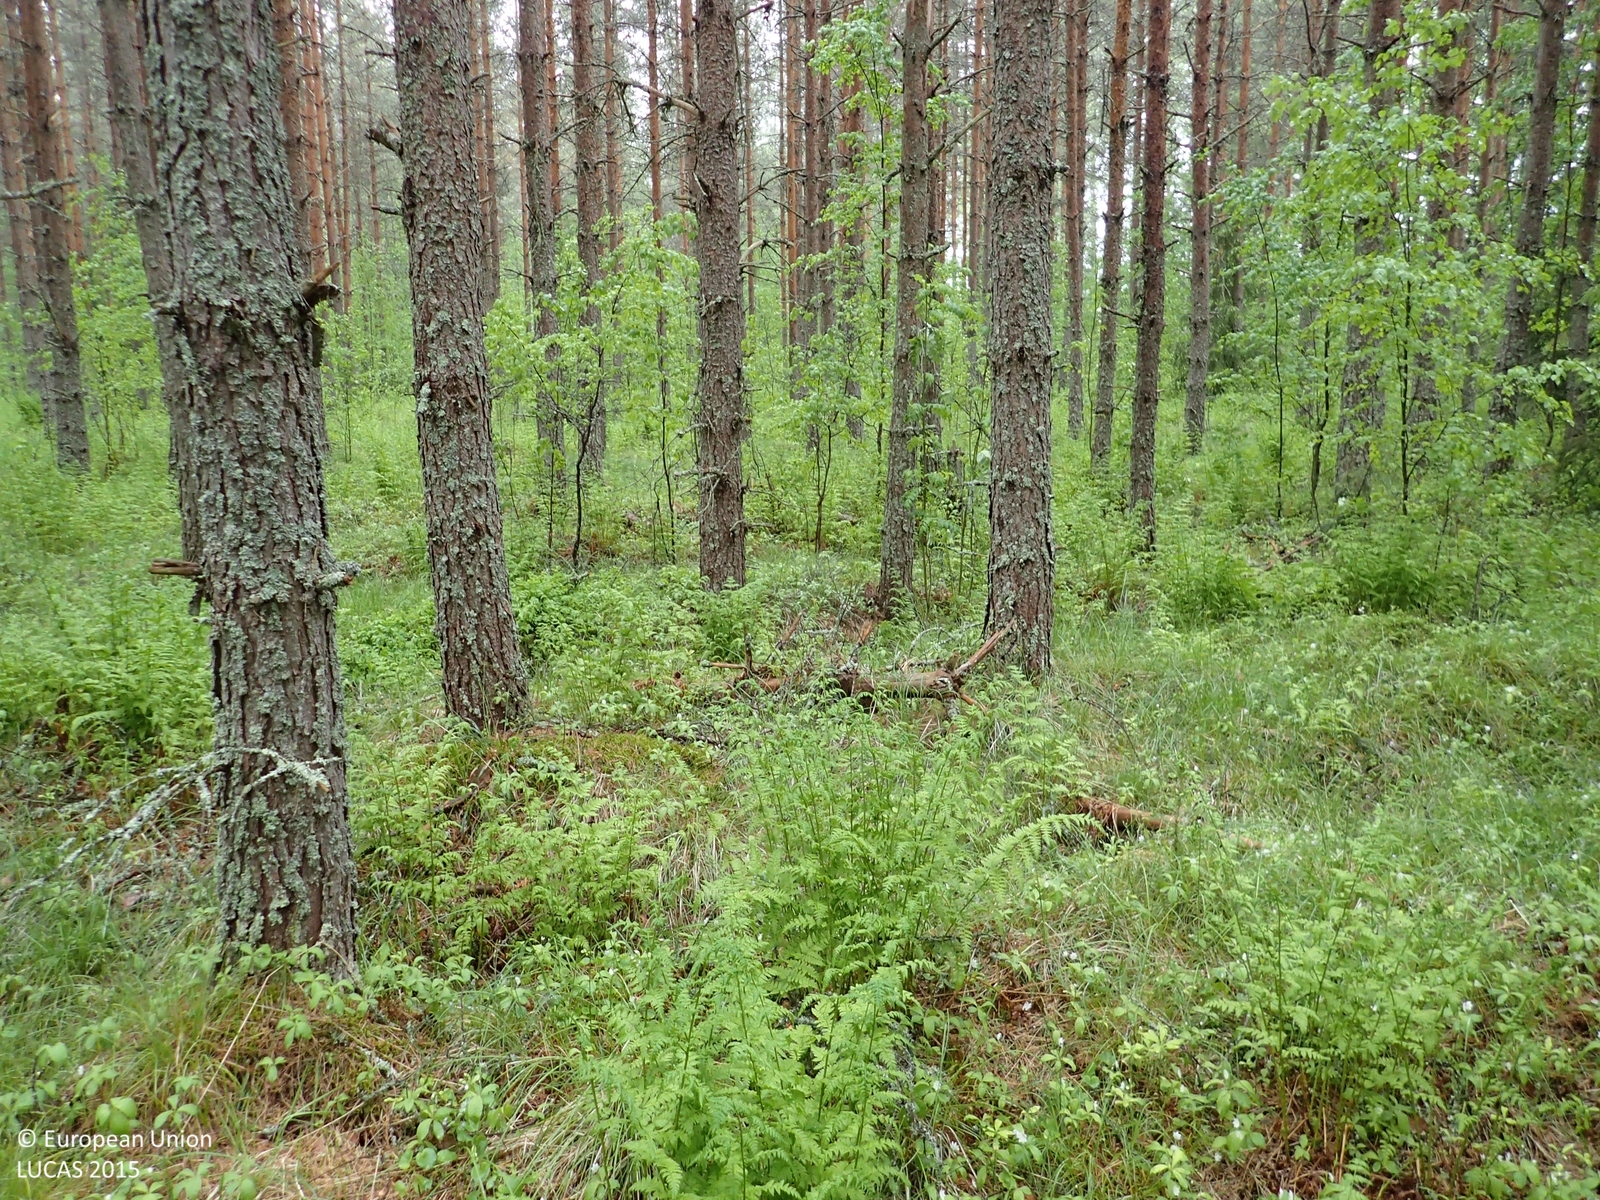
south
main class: Woodland
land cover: Pine dominated coniferous woodland
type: boreal forest
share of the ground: > 75 %
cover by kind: coniferous forest trees 70 %, herbaceous plants 25 %, broadleaved forest trees 5 %
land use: Forestry
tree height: > 5 m
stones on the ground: < 10 %
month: June
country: FI
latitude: 62.4615
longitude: 22.6405
